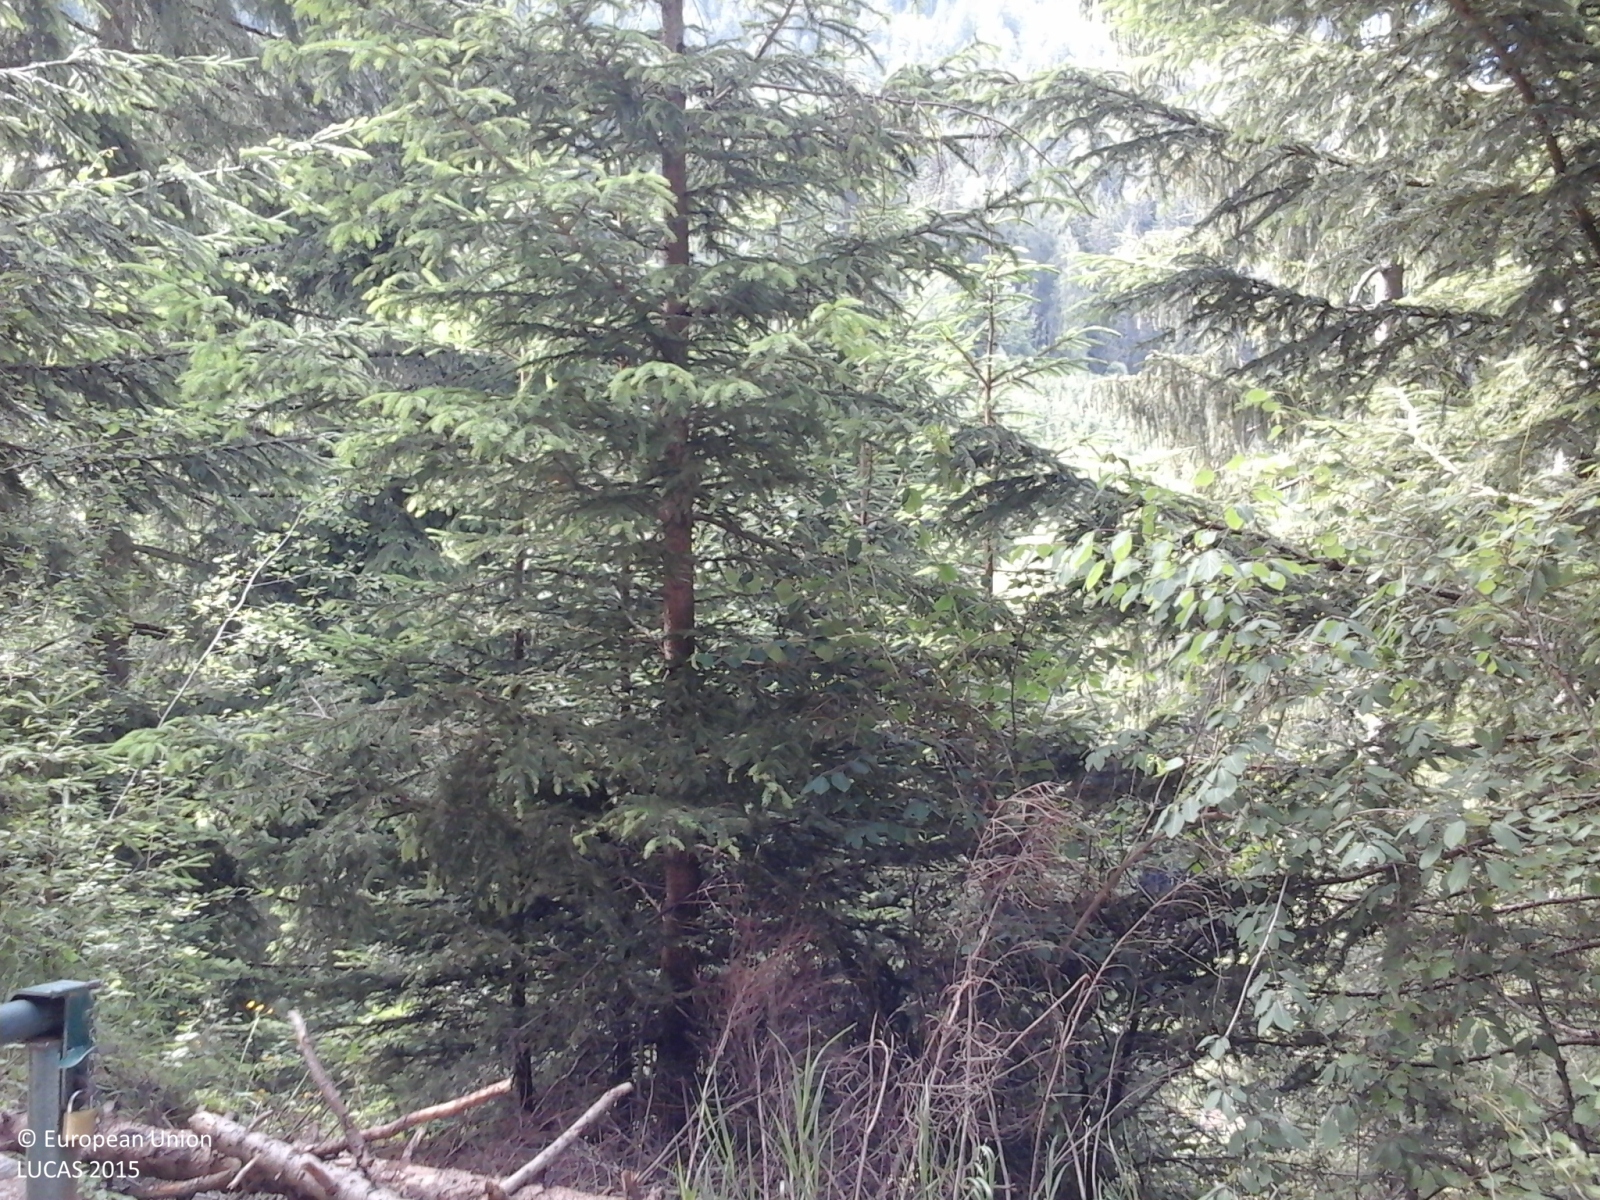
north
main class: Woodland
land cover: Spruce dominated coniferous woodland
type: alpine coniferous forest
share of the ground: > 75 %
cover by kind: coniferous forest trees 100 %
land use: Forestry
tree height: > 5 m
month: June
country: IT
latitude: 46.7718
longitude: 11.5829
